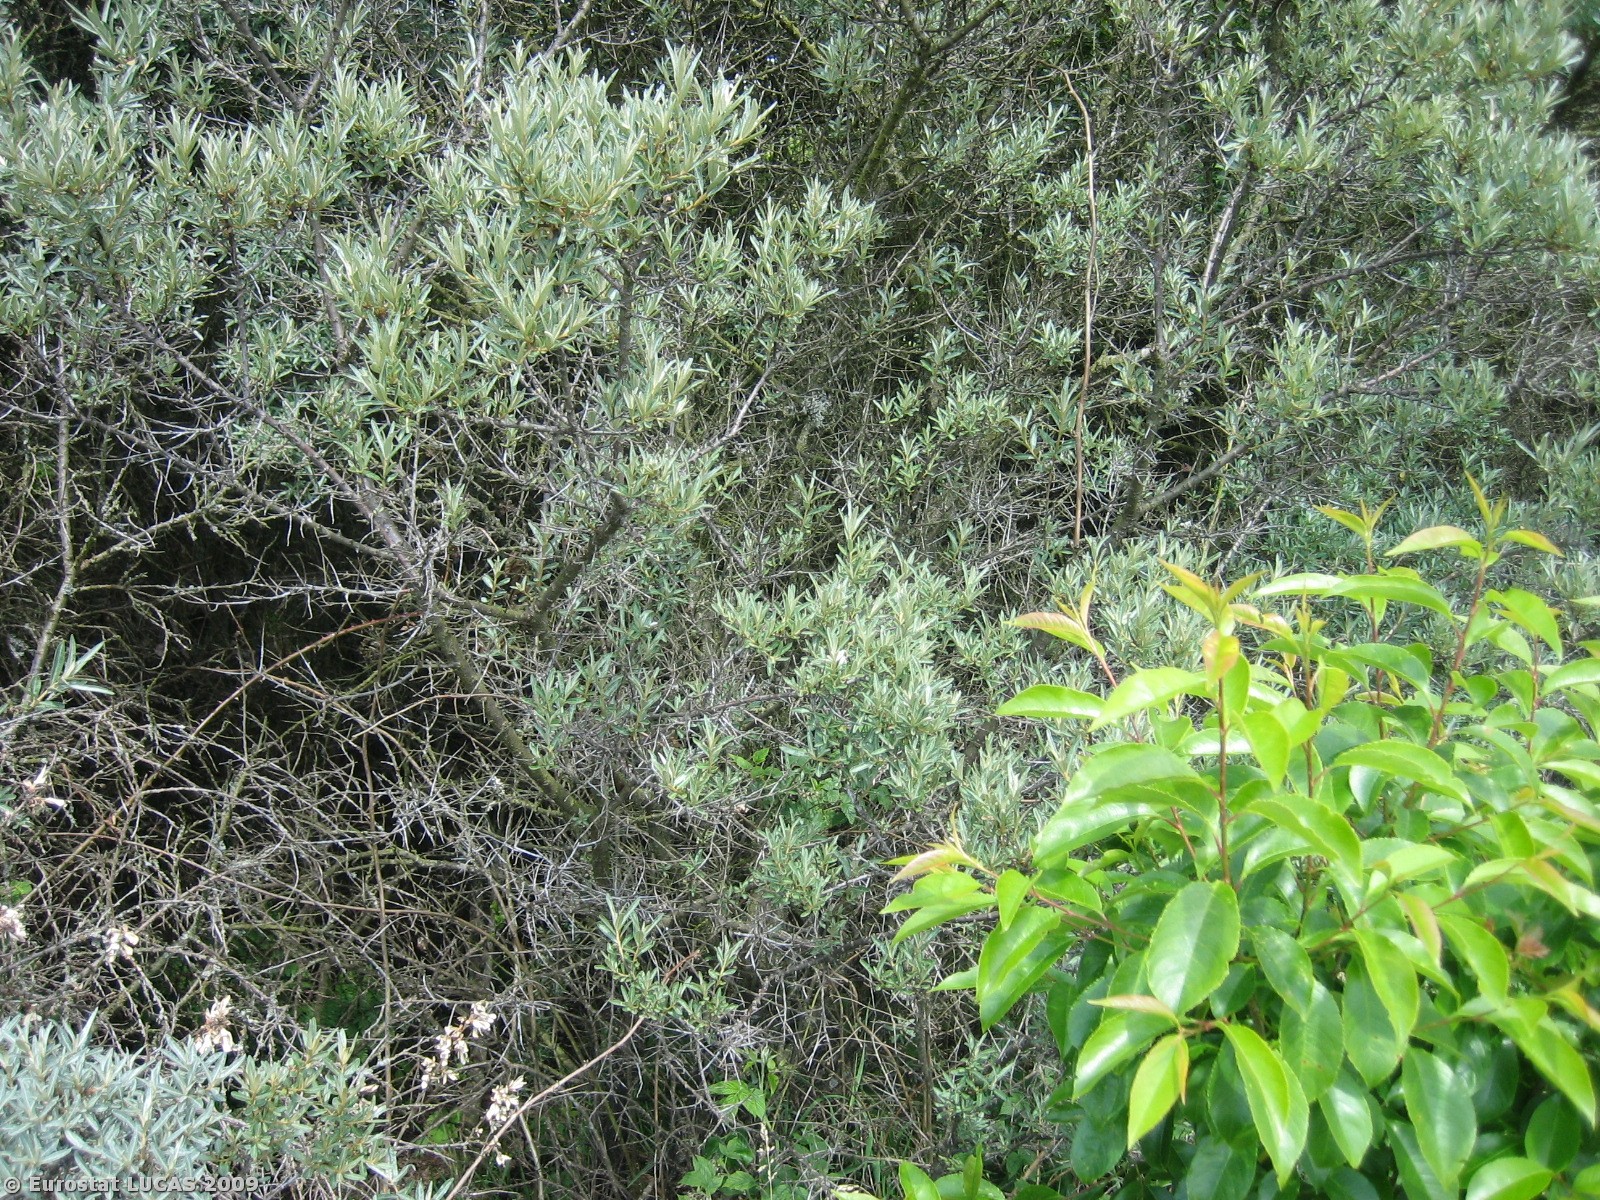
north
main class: Woodland
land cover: Broadleaved woodland
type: mesophytic deciduous forest
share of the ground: > 75 %
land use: Forestry
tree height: > 5 m
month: June
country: DK
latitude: 56.0616
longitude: 9.7273
